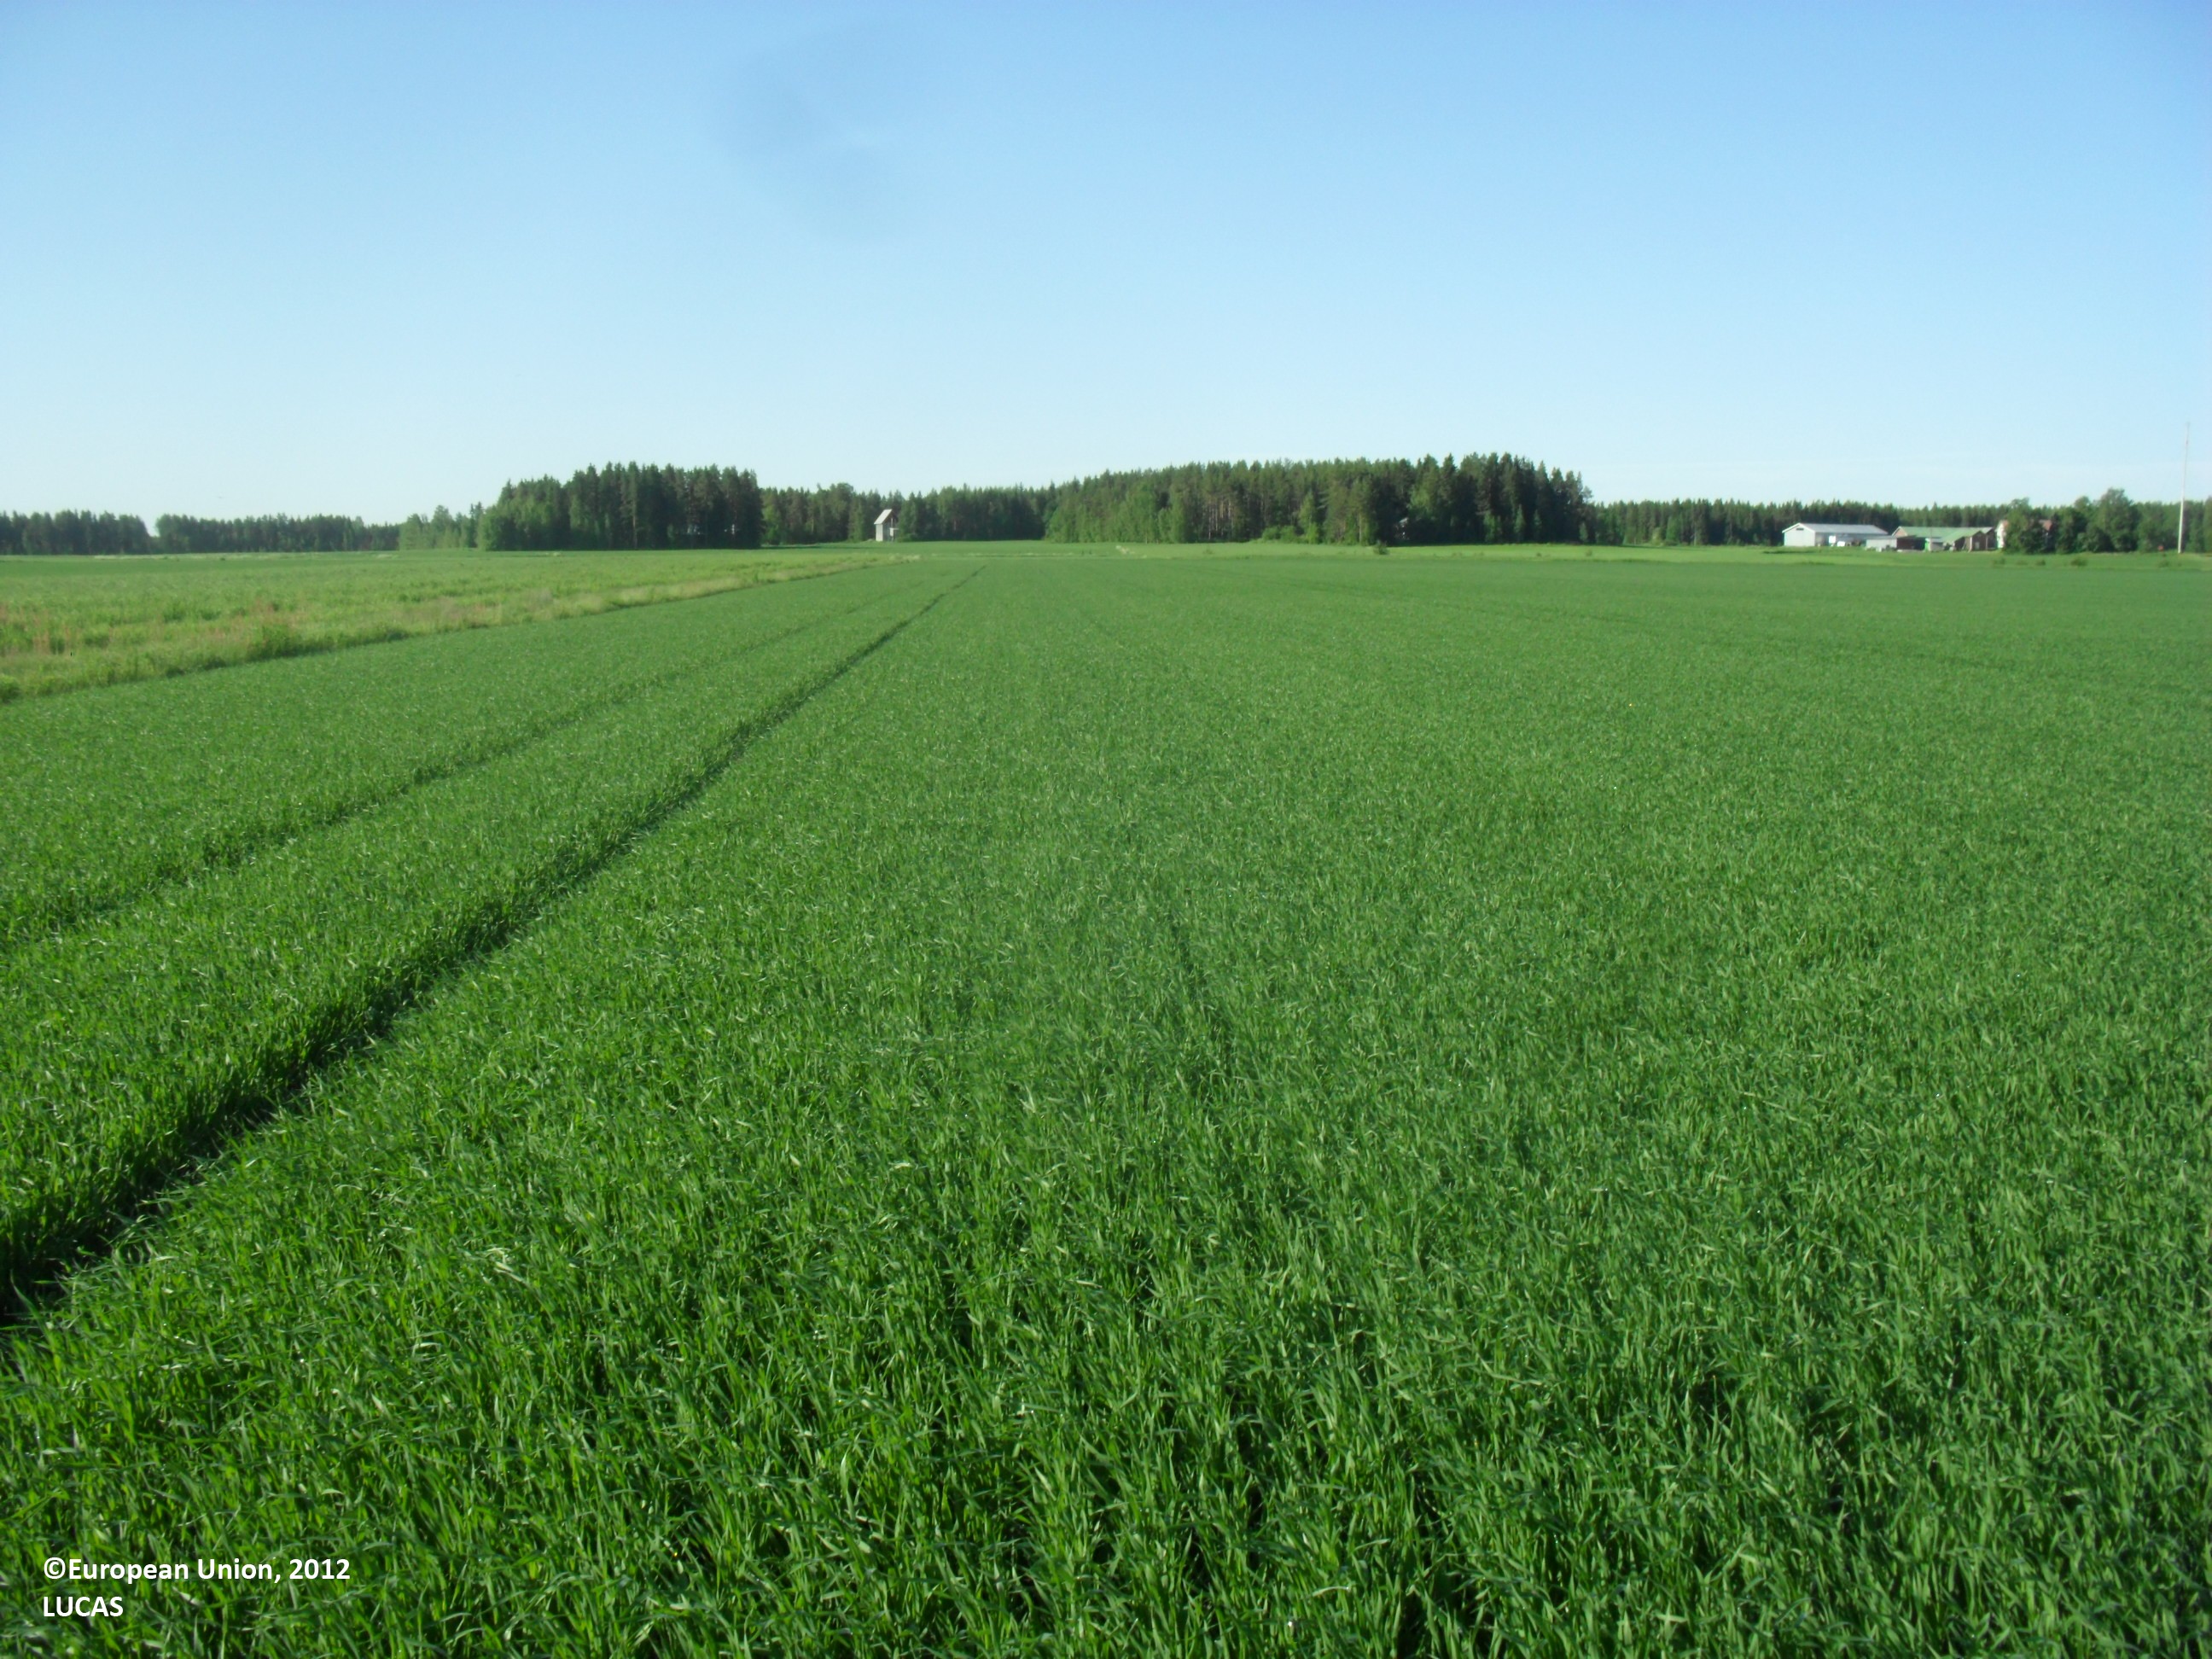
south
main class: Cropland
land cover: Oats
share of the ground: > 75 %
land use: Agriculture (excluding fallow land and kitchen gardens)
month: June
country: FI
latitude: 63.0768
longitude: 22.9442
